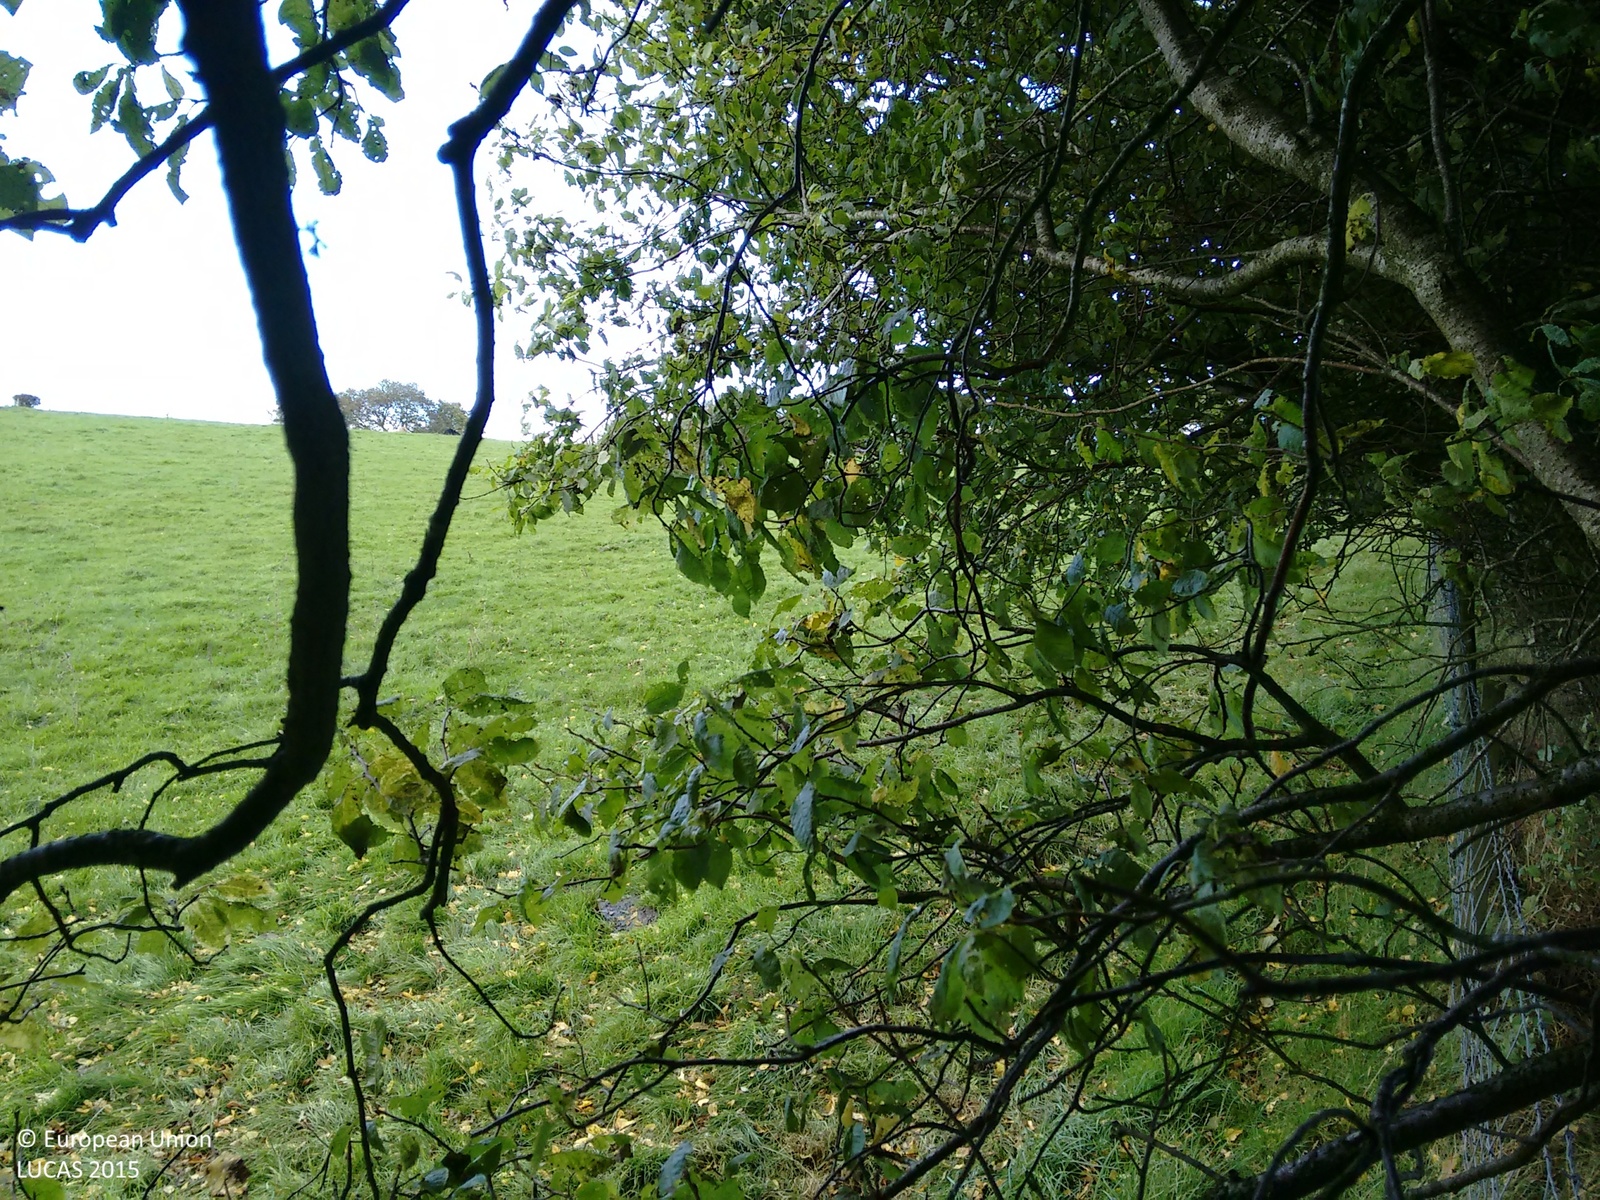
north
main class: Grassland
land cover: Grassland without tree/shrub cover
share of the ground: > 75 %
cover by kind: herbaceous plants 100 %
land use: Agriculture (excluding fallow land and kitchen gardens)
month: October
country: GB
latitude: 52.3706
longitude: -3.3144
